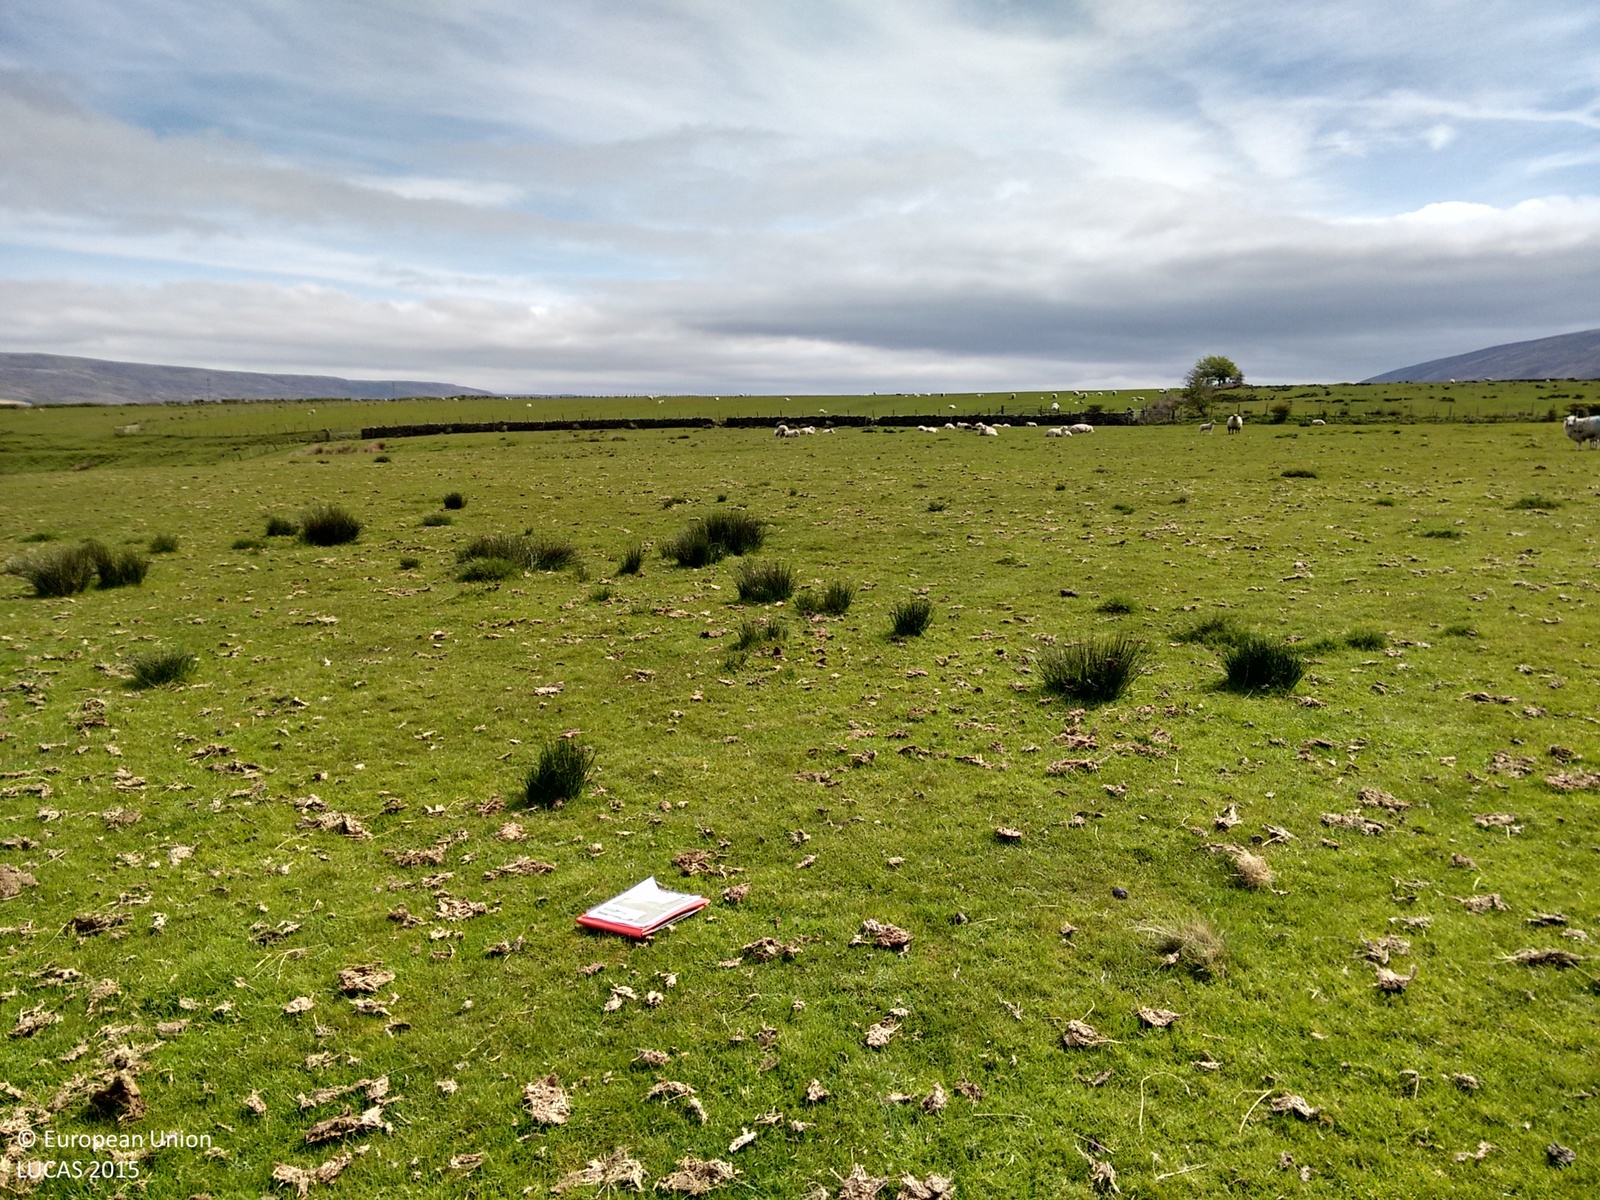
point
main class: Grassland
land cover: Grassland without tree/shrub cover
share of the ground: > 75 %
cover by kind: herbaceous plants 100 %
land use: Agriculture (excluding fallow land and kitchen gardens)
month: May
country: GB
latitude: 53.9677
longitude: -2.7054
